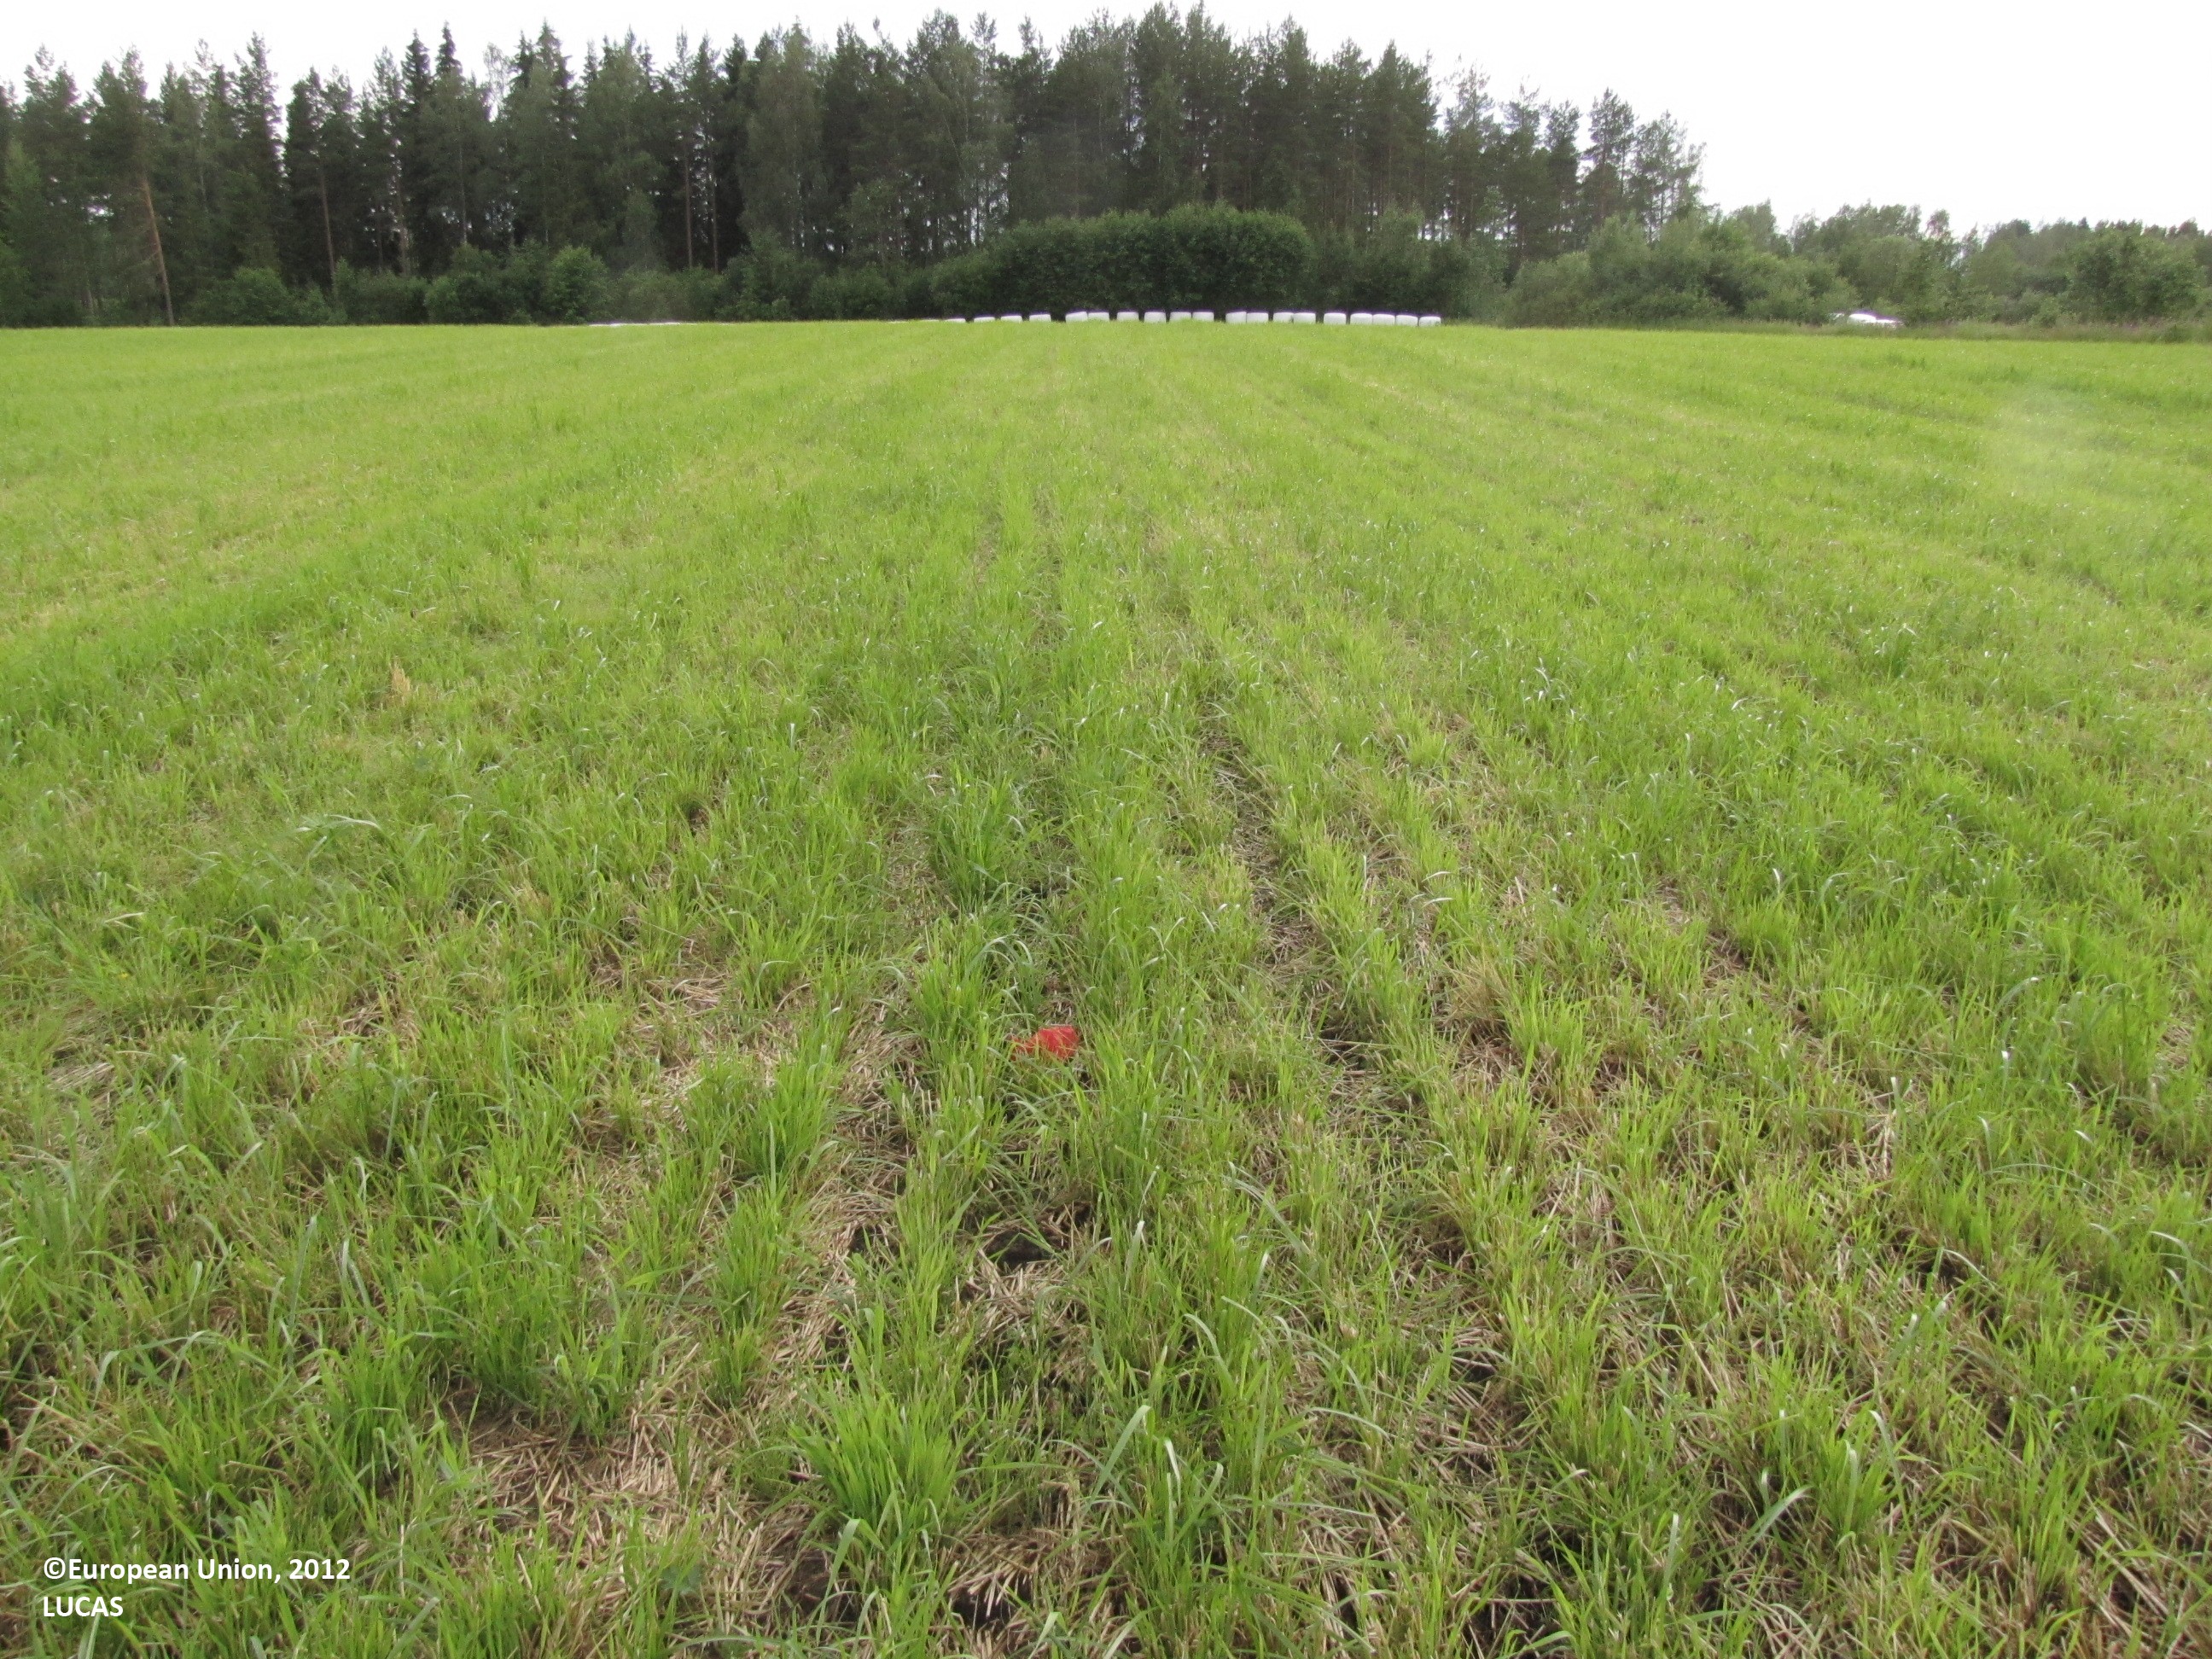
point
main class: Cropland
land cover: Temporary grasslands
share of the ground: > 75 %
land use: Agriculture (excluding fallow land and kitchen gardens)
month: July
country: FI
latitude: 62.4344
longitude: 23.9683
